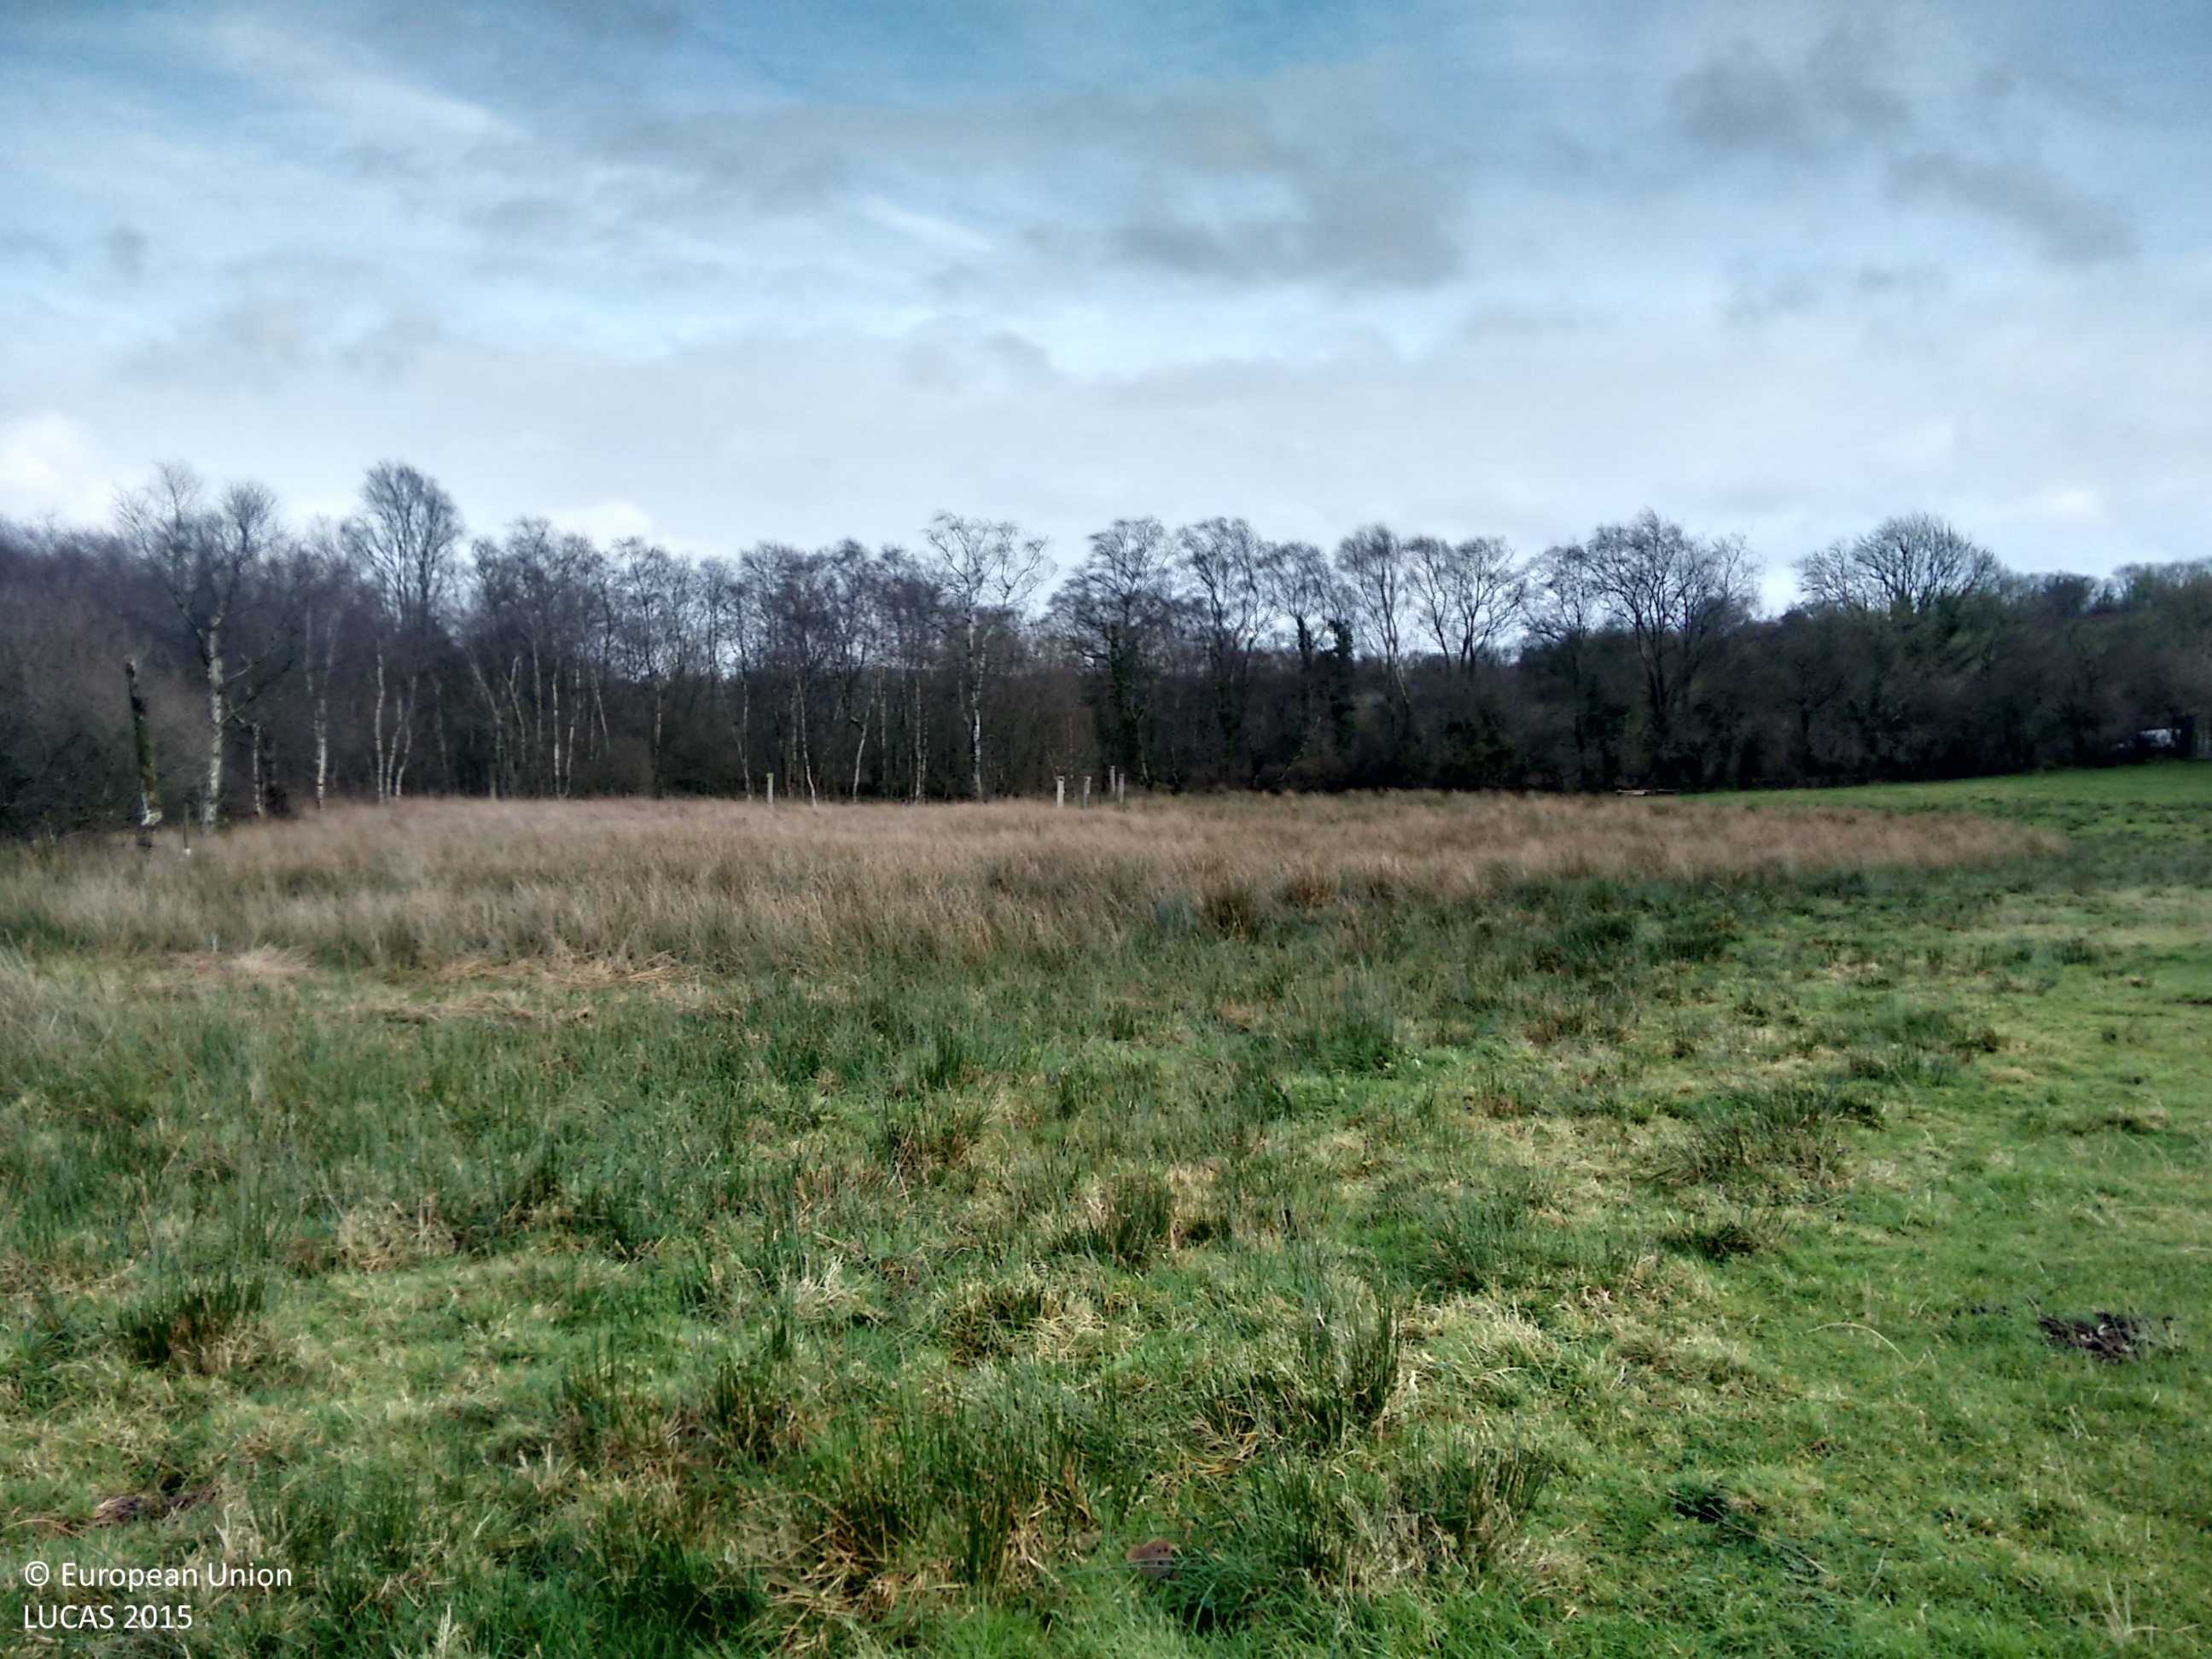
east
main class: Grassland
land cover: Grassland without tree/shrub cover
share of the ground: > 75 %
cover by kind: herbaceous plants 100 %
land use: Agriculture (excluding fallow land and kitchen gardens)
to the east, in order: Grassland without tree/shrub cover; Fences; Broadleaved woodland; Shruby margins; Tracks; Abandoned hedges; Grassland without tree/shrub cover; Broadleaved woodland; Inland marshes; Grassland without tree/shrub cover
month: December
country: IE
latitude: 53.9690
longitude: -6.8910
